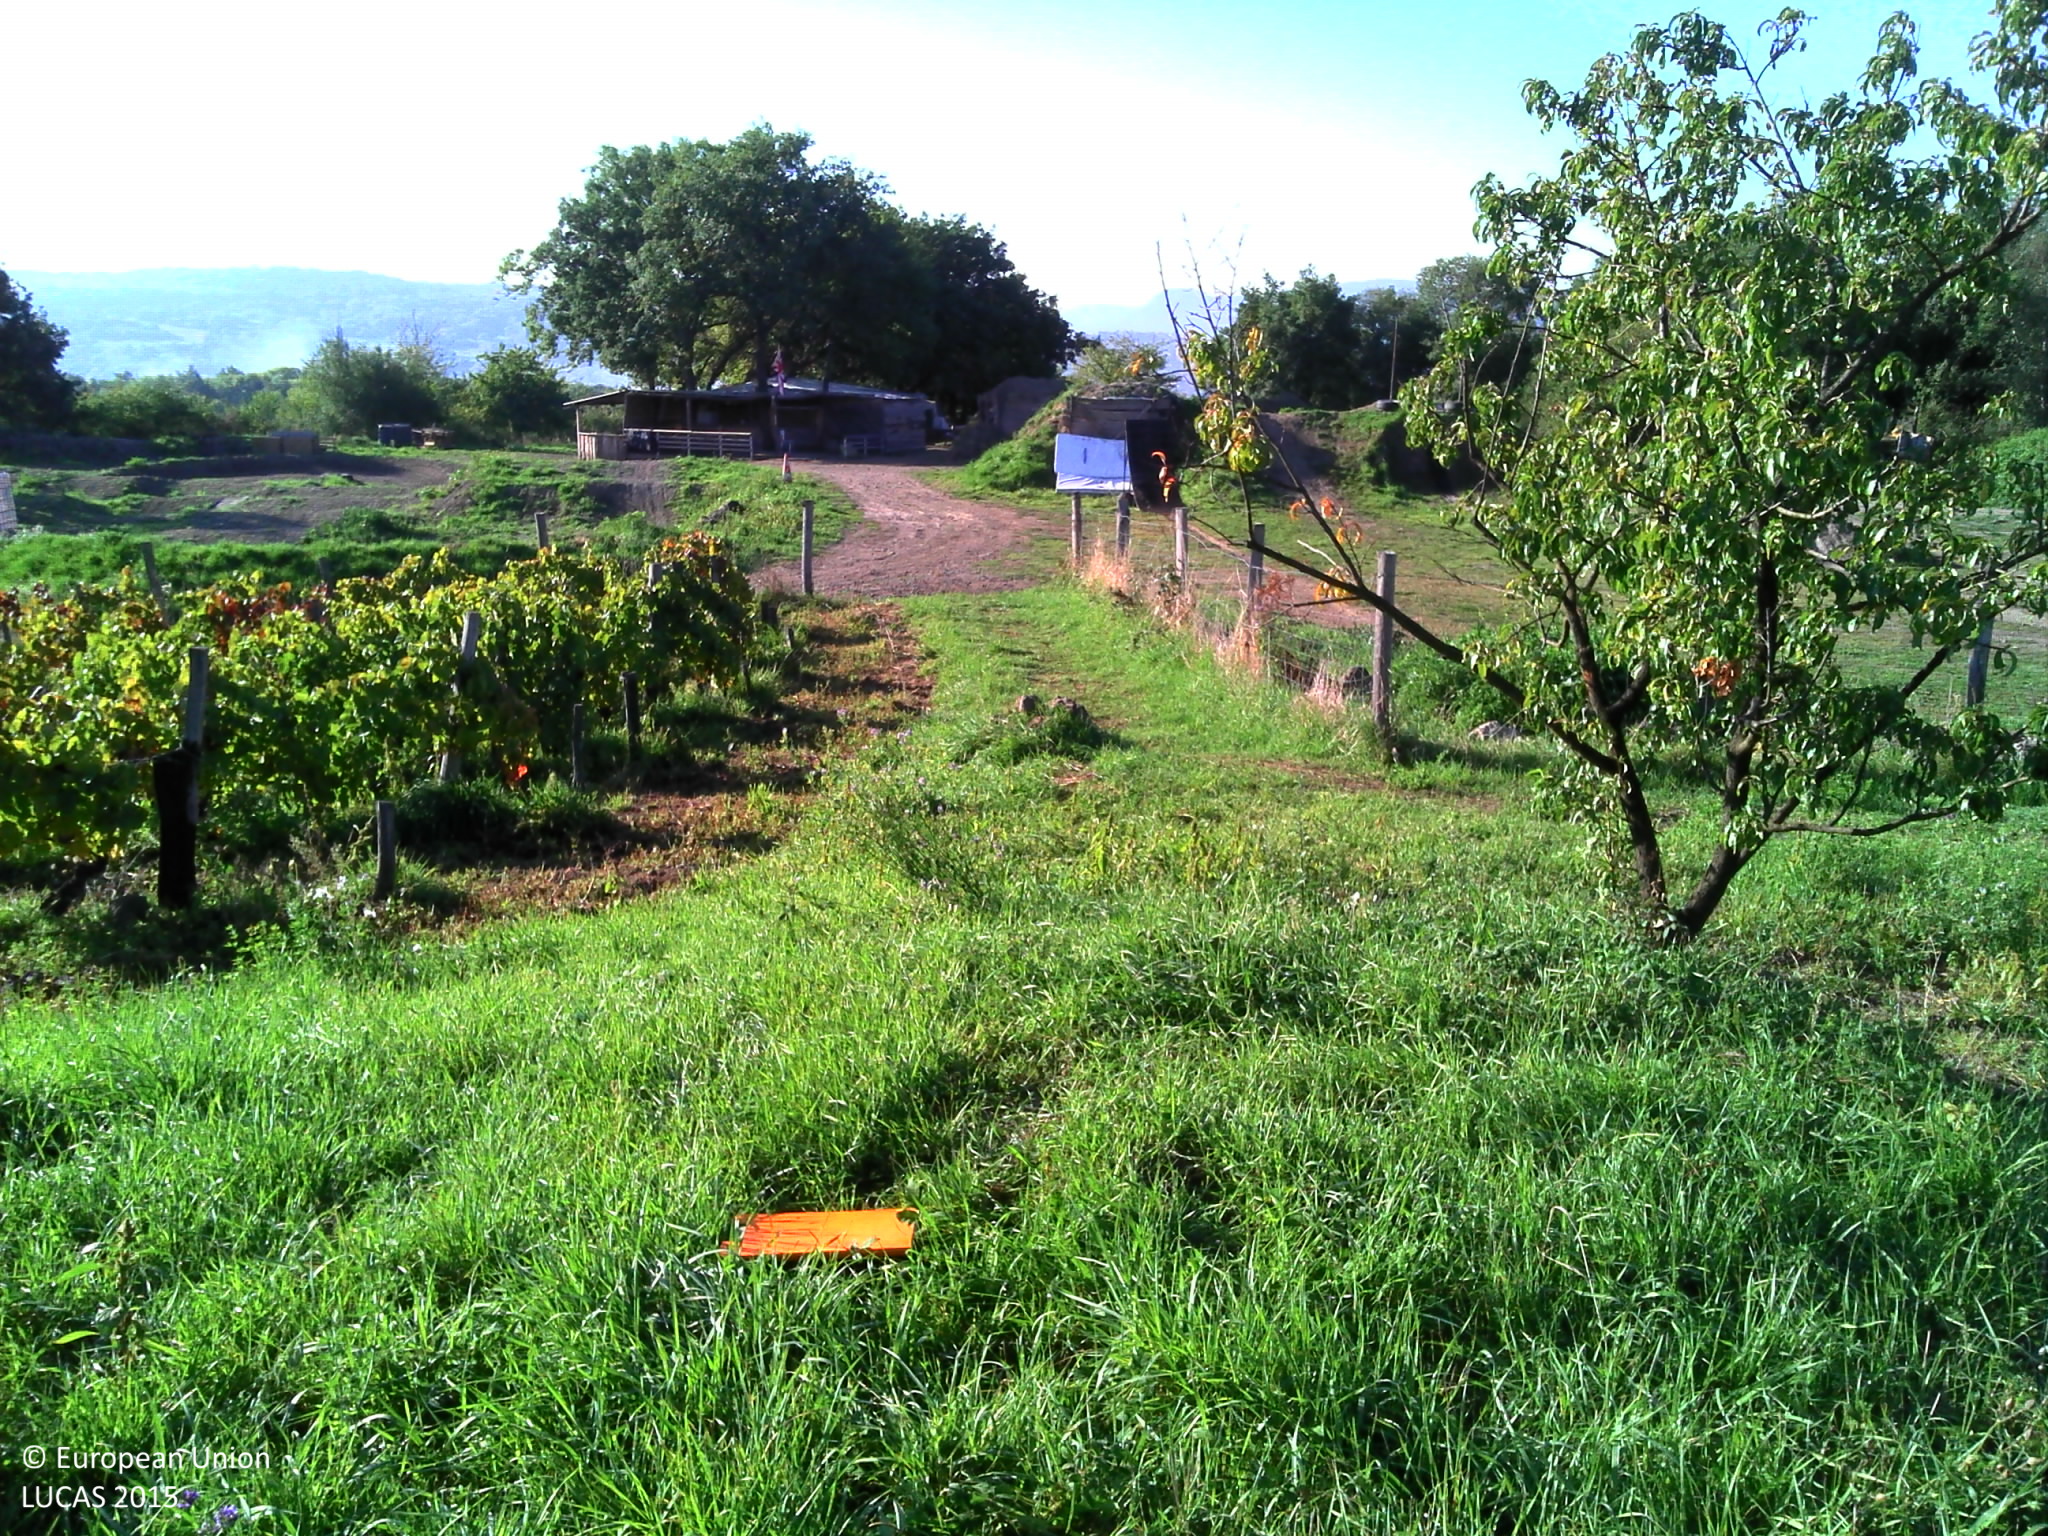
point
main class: Grassland
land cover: Grassland with sparse tree/shrub cover
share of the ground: > 75 %
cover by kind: herbaceous plants 95 %, broadleaved forest trees 5 %
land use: Agriculture (excluding fallow land and kitchen gardens)
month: September
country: FR
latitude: 45.8364
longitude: 3.0600
